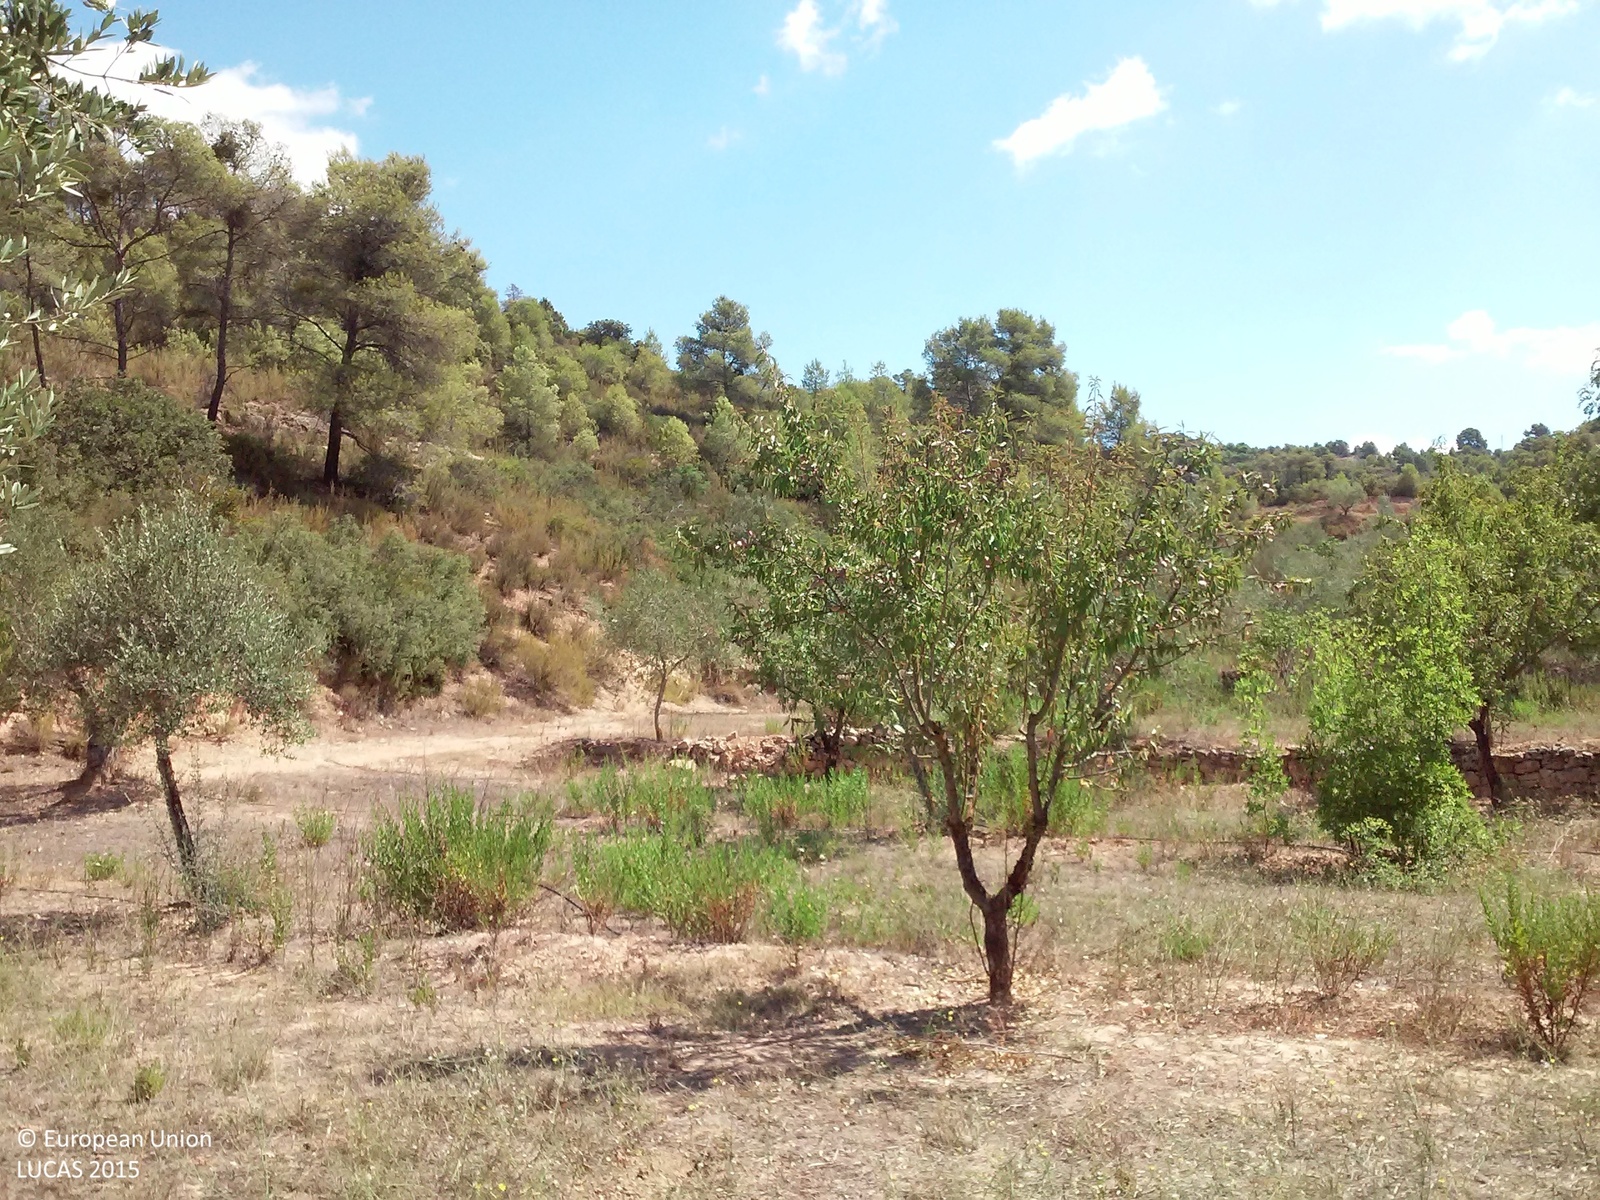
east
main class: Cropland
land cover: Olive groves
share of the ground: 10 - 25 %
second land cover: Other bare soil
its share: > 75 %
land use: Agriculture (excluding fallow land and kitchen gardens)
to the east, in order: Olive groves; Other bare soil; Dry stone walls; Olive groves; Dry stone walls; Olive groves; Dry stone walls; Tracks; Pine dominated coniferous woodland; Tracks; Olive groves; Dry stone walls; Olive groves; Tracks; Pine dominated coniferous woodland
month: August
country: ES
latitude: 41.2927
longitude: 0.6402
